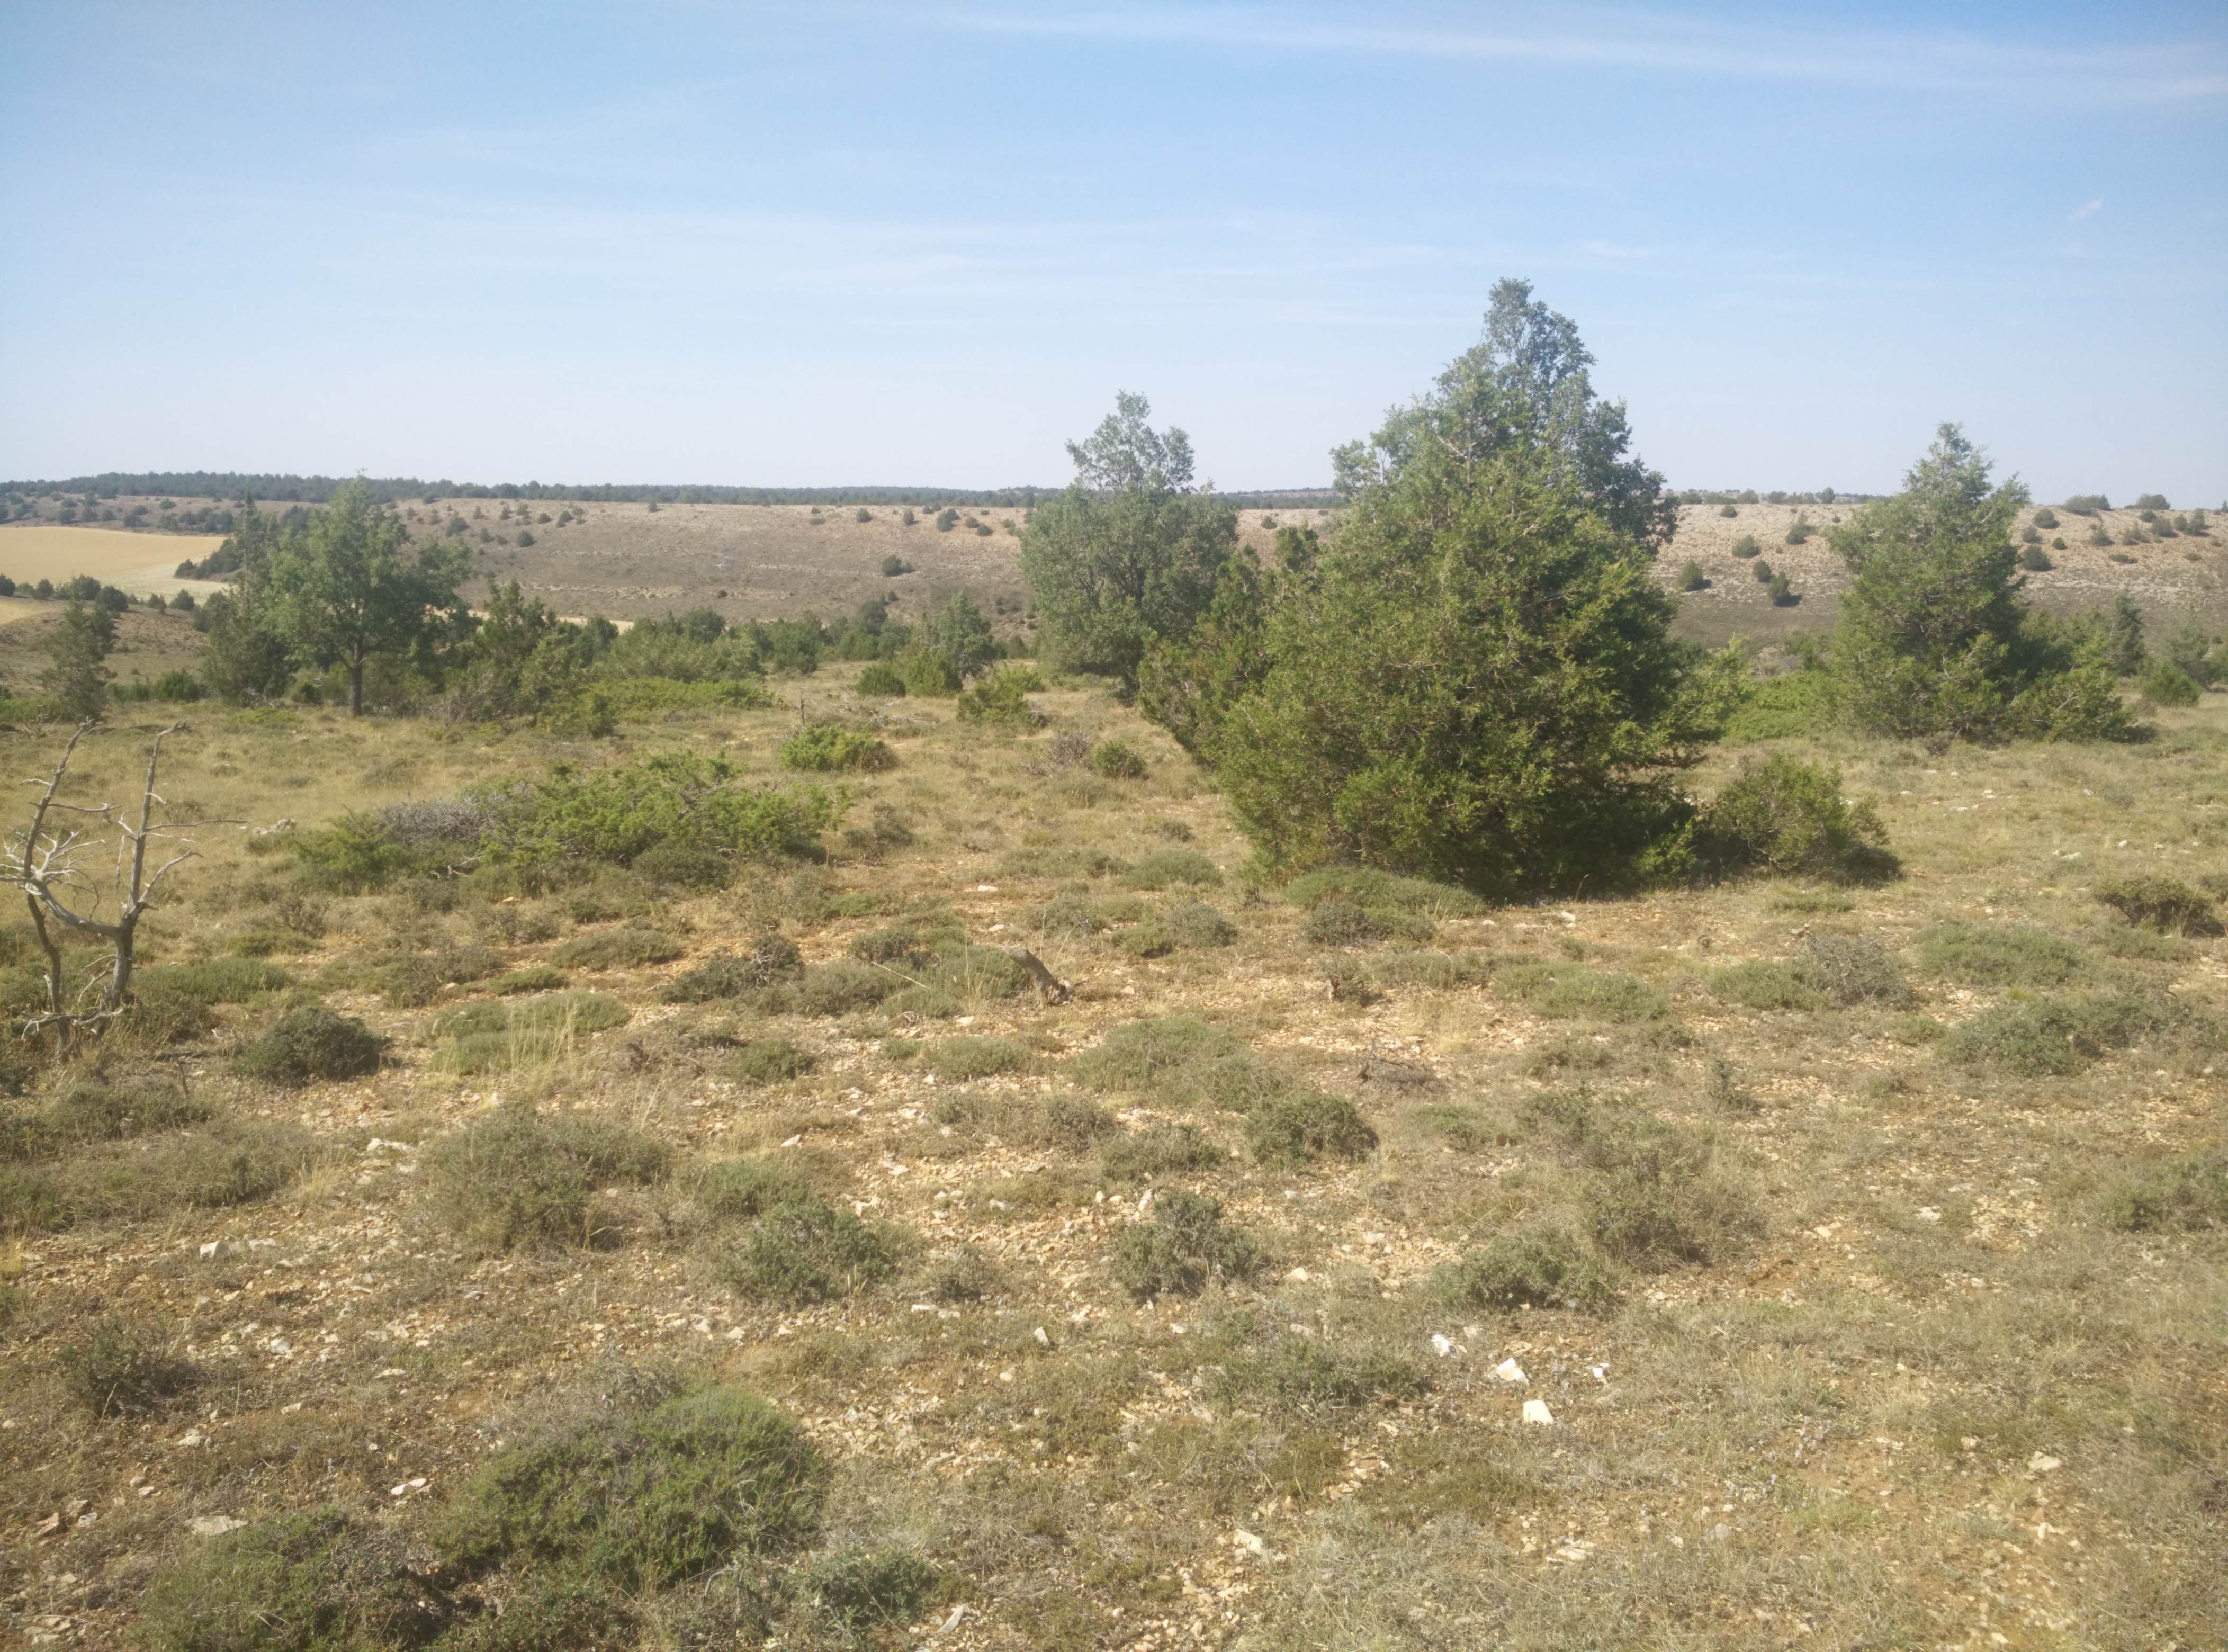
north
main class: Shrubland
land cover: Shrubland with sparse tree cover
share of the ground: 25 - 50 %
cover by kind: shrubs 40 %, herbaceous plants 35 %, unconsolidated bare surface 20 %, coniferous forest trees 5 %
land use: Semi-natural and natural areas not in use
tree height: > 5 m
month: July
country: ES
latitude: 41.0616
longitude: -2.1528
